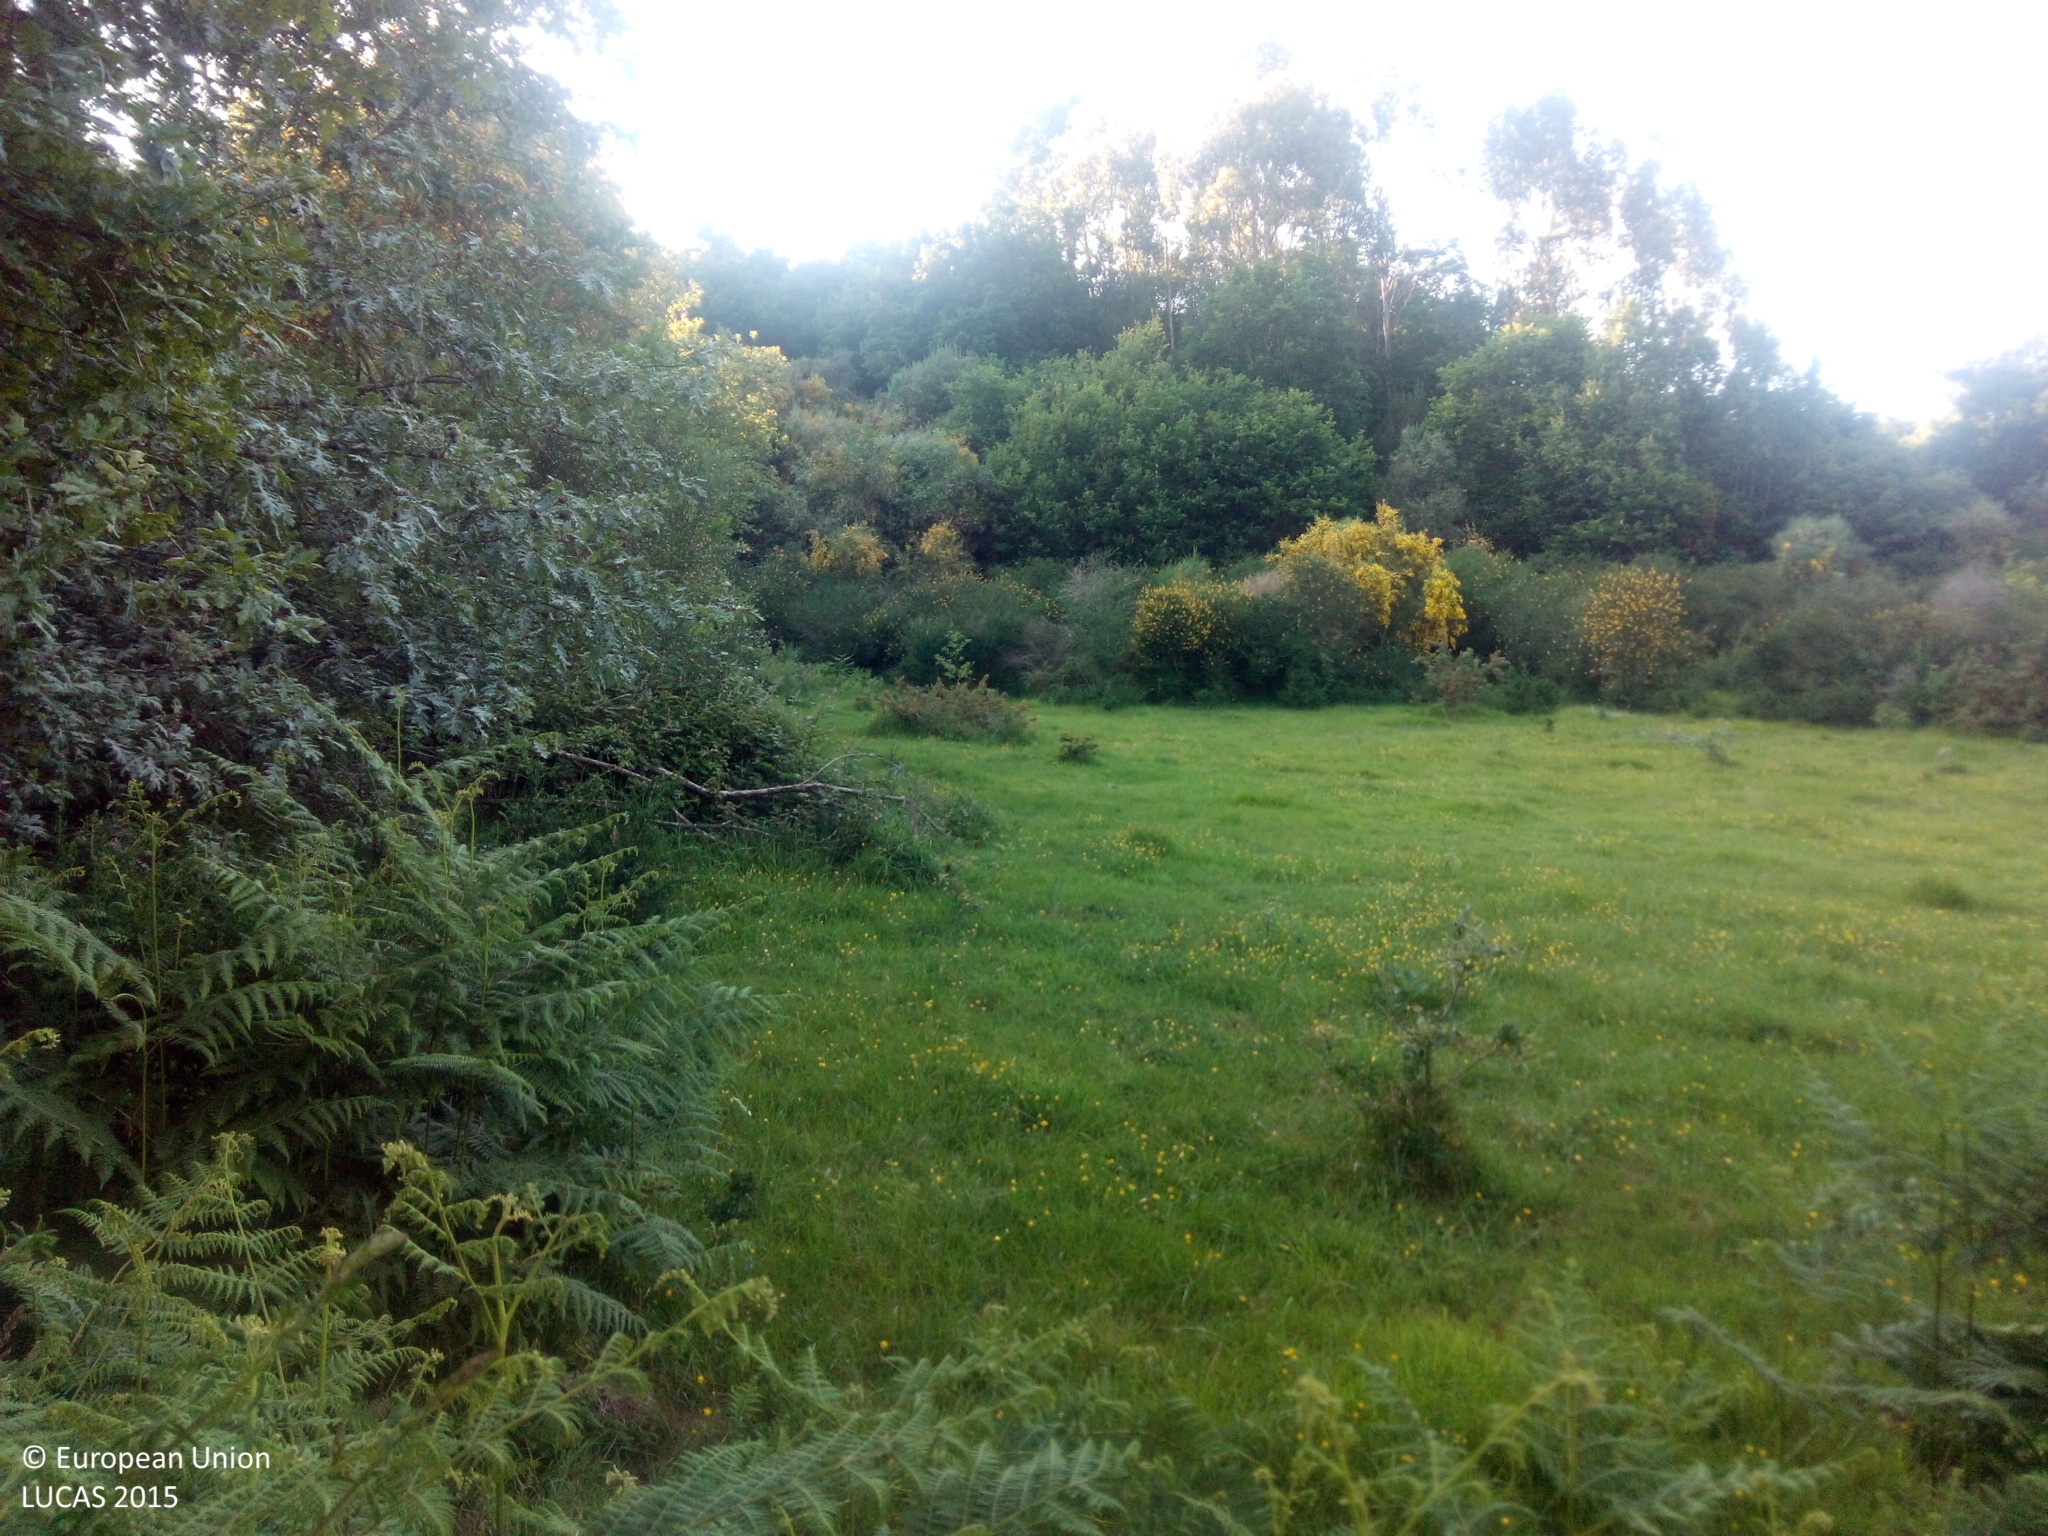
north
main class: Grassland
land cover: Grassland with sparse tree/shrub cover
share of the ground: > 75 %
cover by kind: herbaceous plants 95 %, broadleaved forest trees 5 %
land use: Agriculture (excluding fallow land and kitchen gardens)
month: June
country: ES
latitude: 42.2436
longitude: -8.3036
